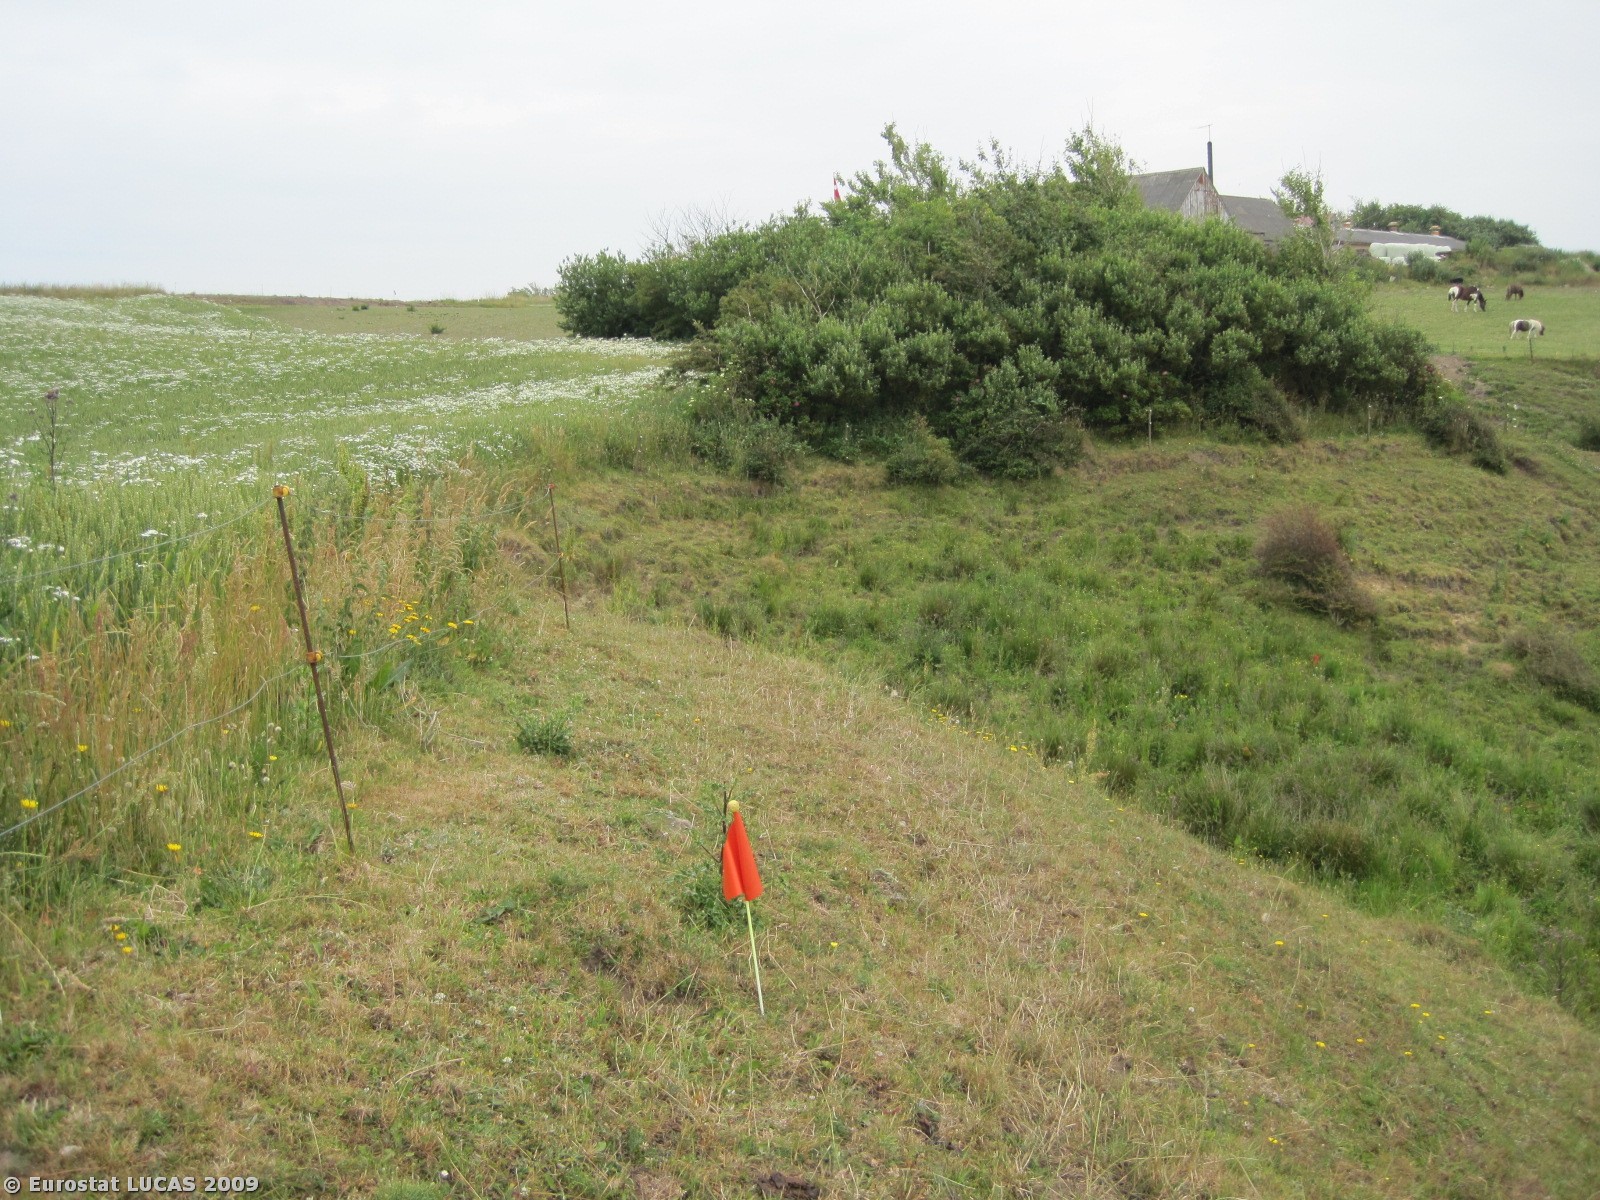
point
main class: Grassland
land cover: Grassland with sparse tree/shrub cover
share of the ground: > 75 %
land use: Agriculture (excluding fallow land and kitchen gardens)
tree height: < 5 m
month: June
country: DK
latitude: 56.5365
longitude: 8.3272
